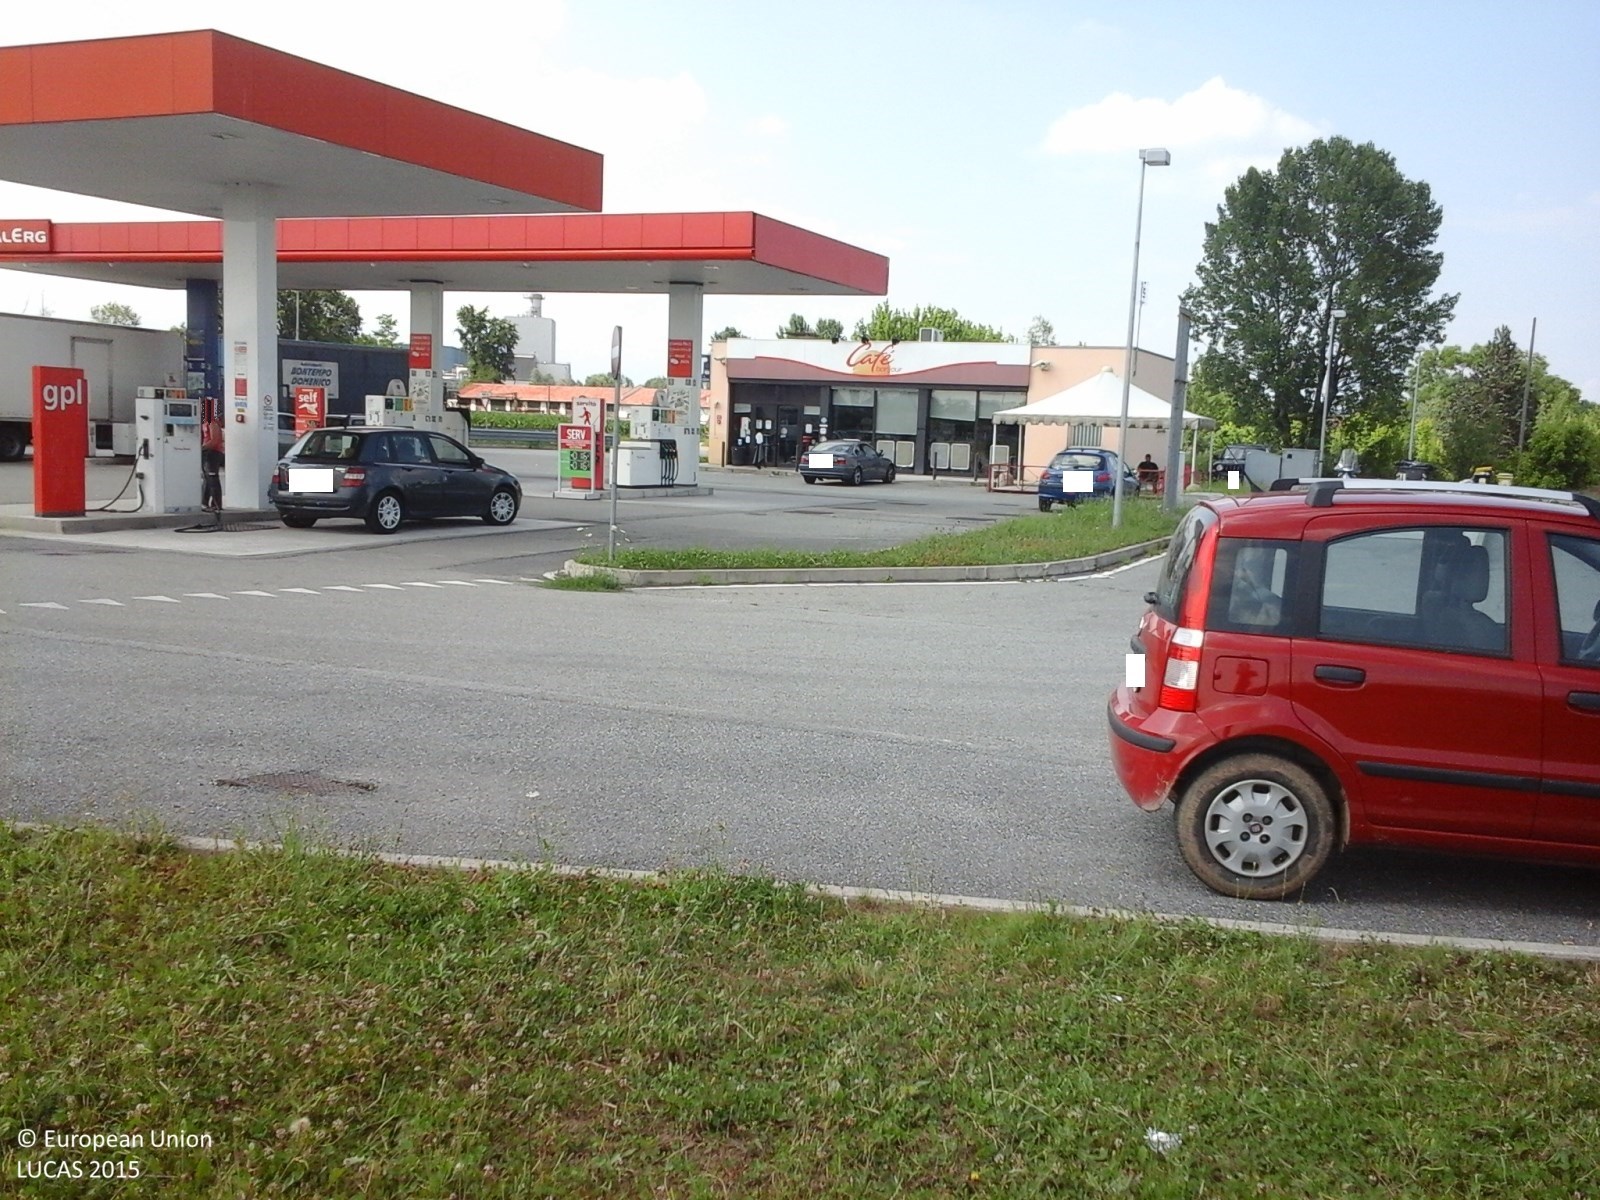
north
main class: Cropland
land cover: Maize
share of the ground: > 75 %
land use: Agriculture (excluding fallow land and kitchen gardens)
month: June
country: IT
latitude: 45.1559
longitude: 7.7524
